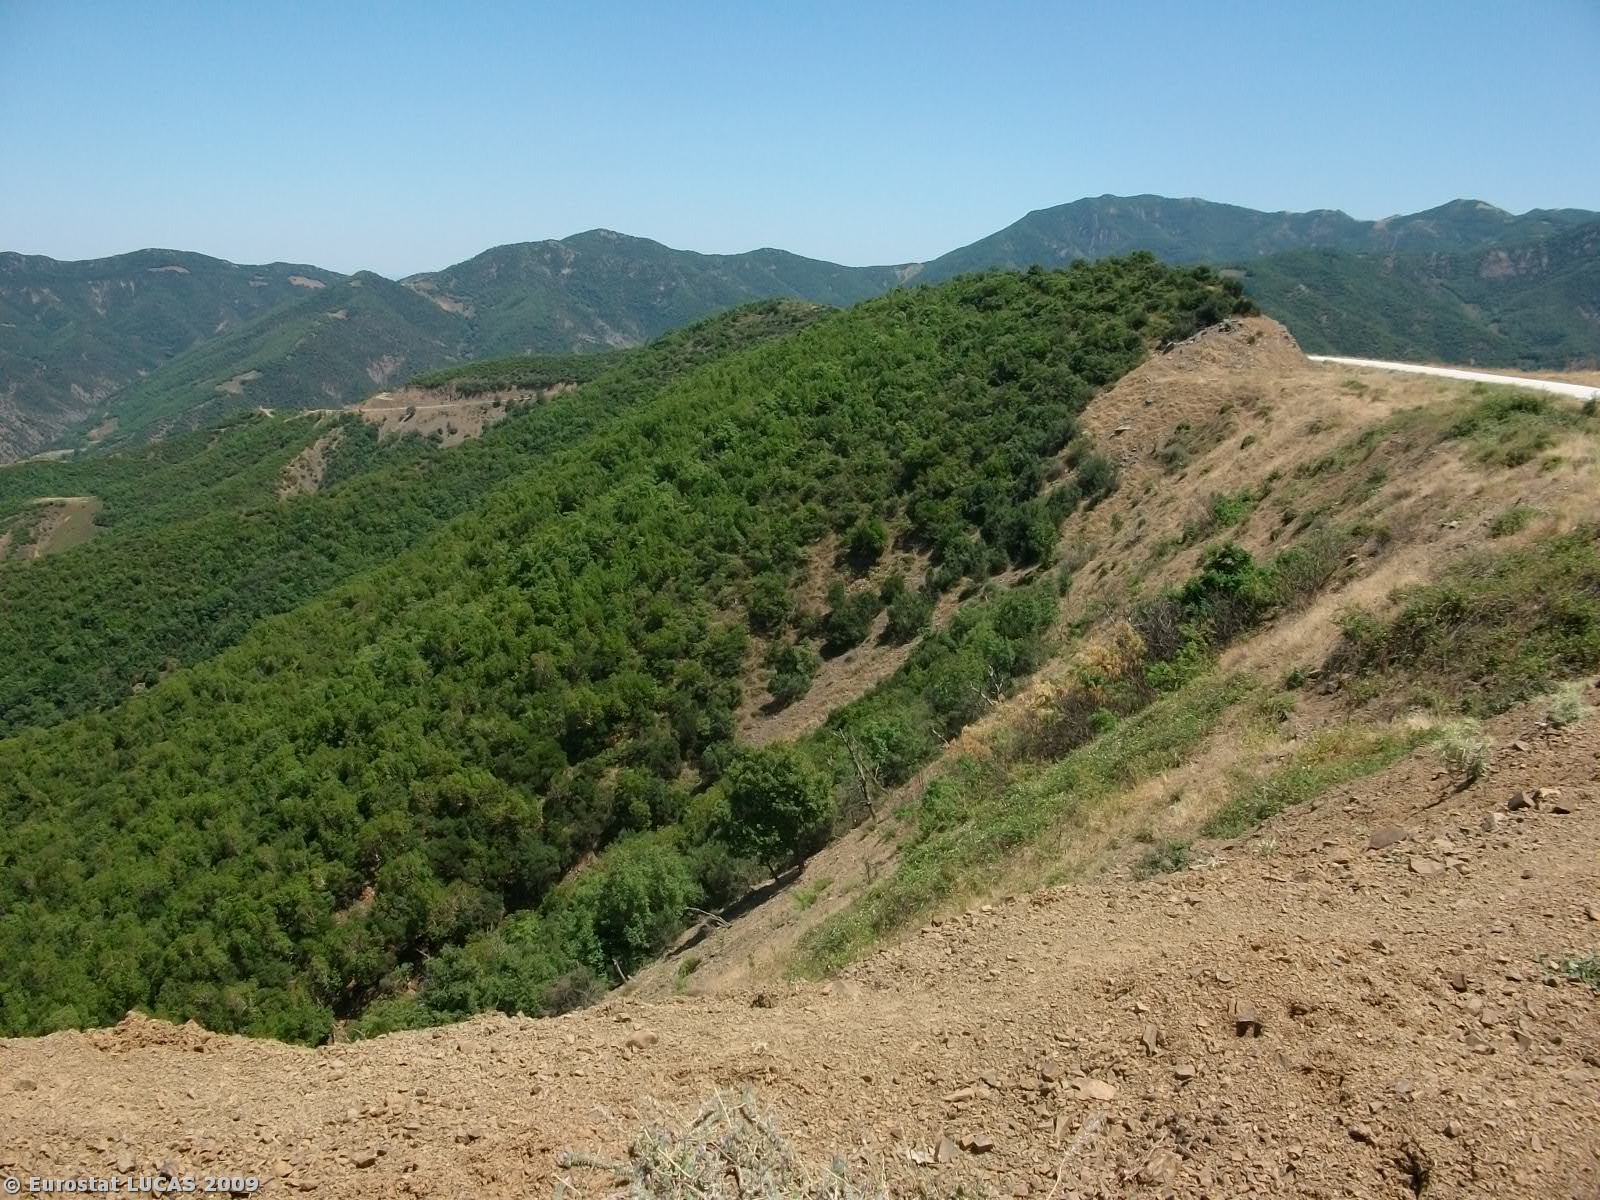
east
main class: Woodland
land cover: Broadleaved woodland
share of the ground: > 75 %
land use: Forestry
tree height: < 5 m
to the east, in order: Broadleaved woodland; Ditches and canals; Broadleaved woodland
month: July
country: GR
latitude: 39.1910
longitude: 21.9170
